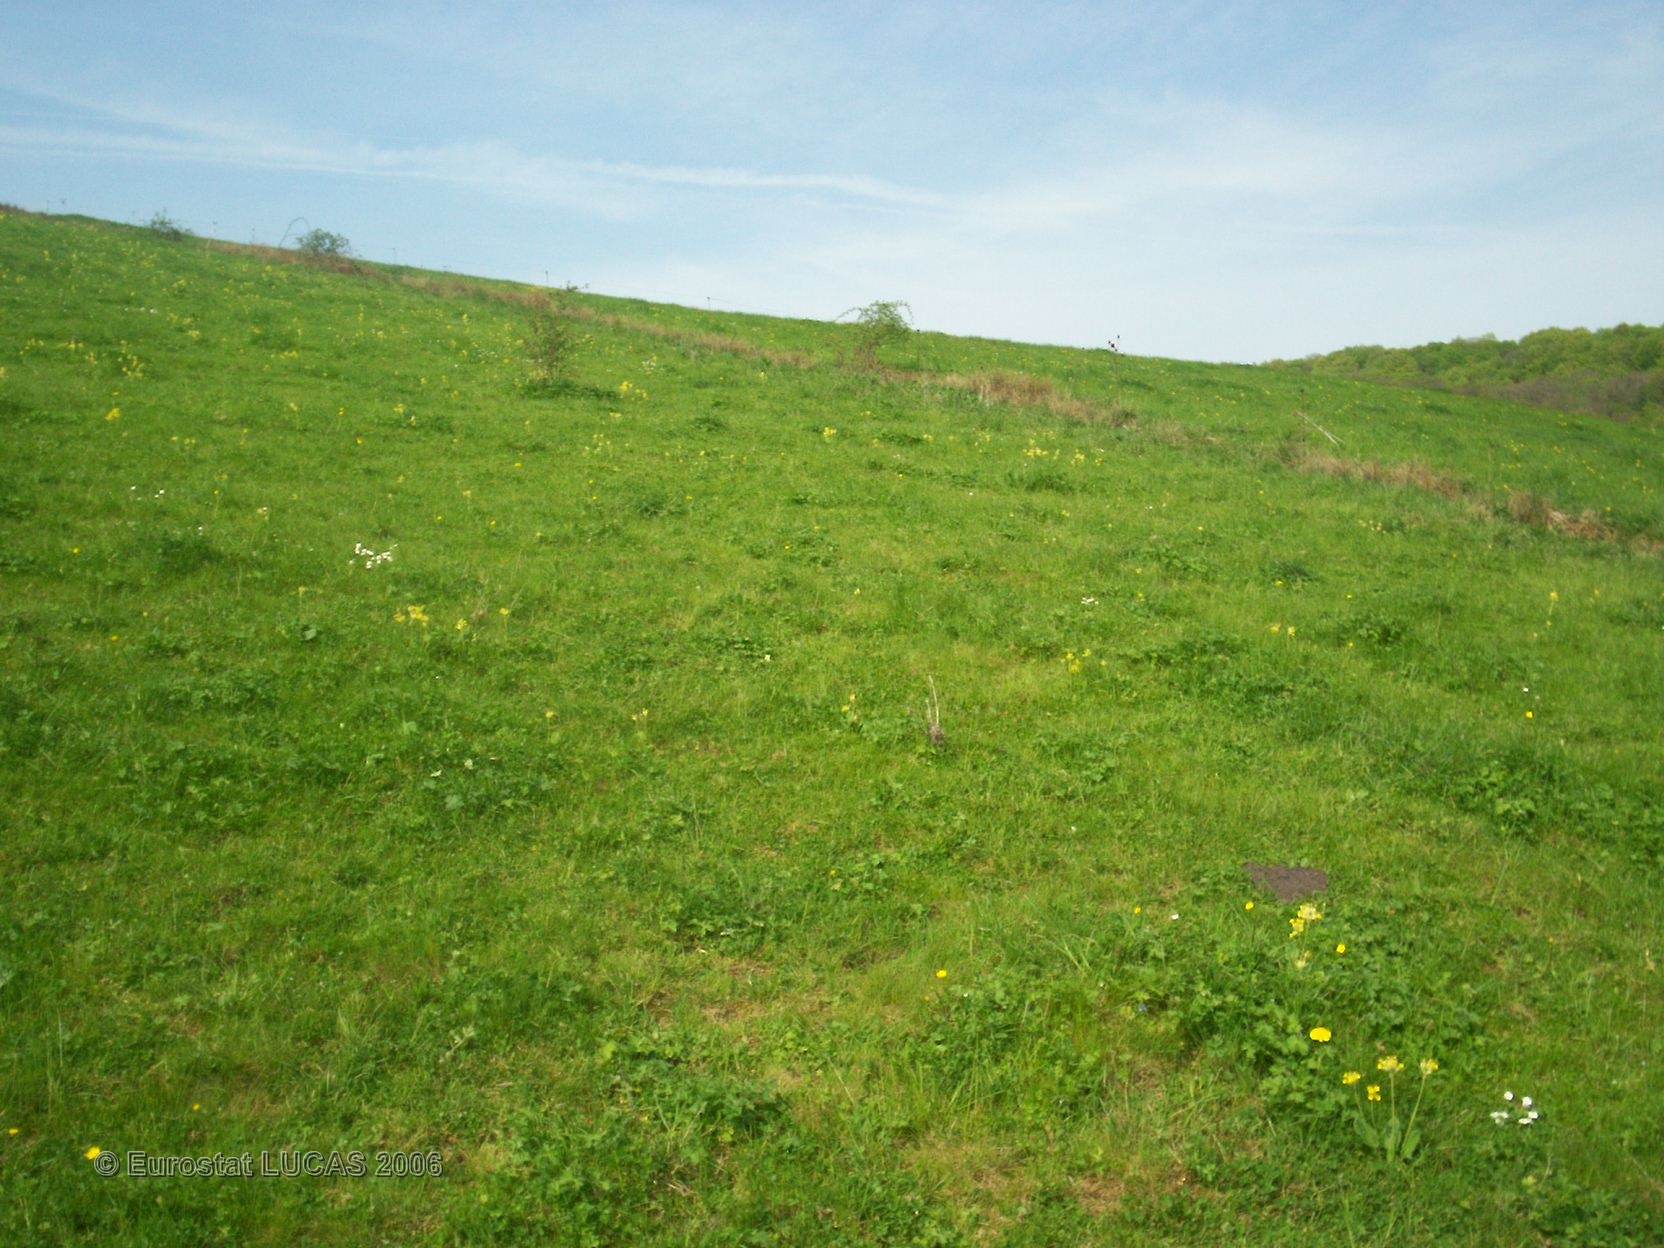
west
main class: Grassland
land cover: Grassland without tree/shrub cover
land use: Agriculture (excluding fallow land and kitchen gardens)
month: May
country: FR
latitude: 47.4446
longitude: 4.6552
